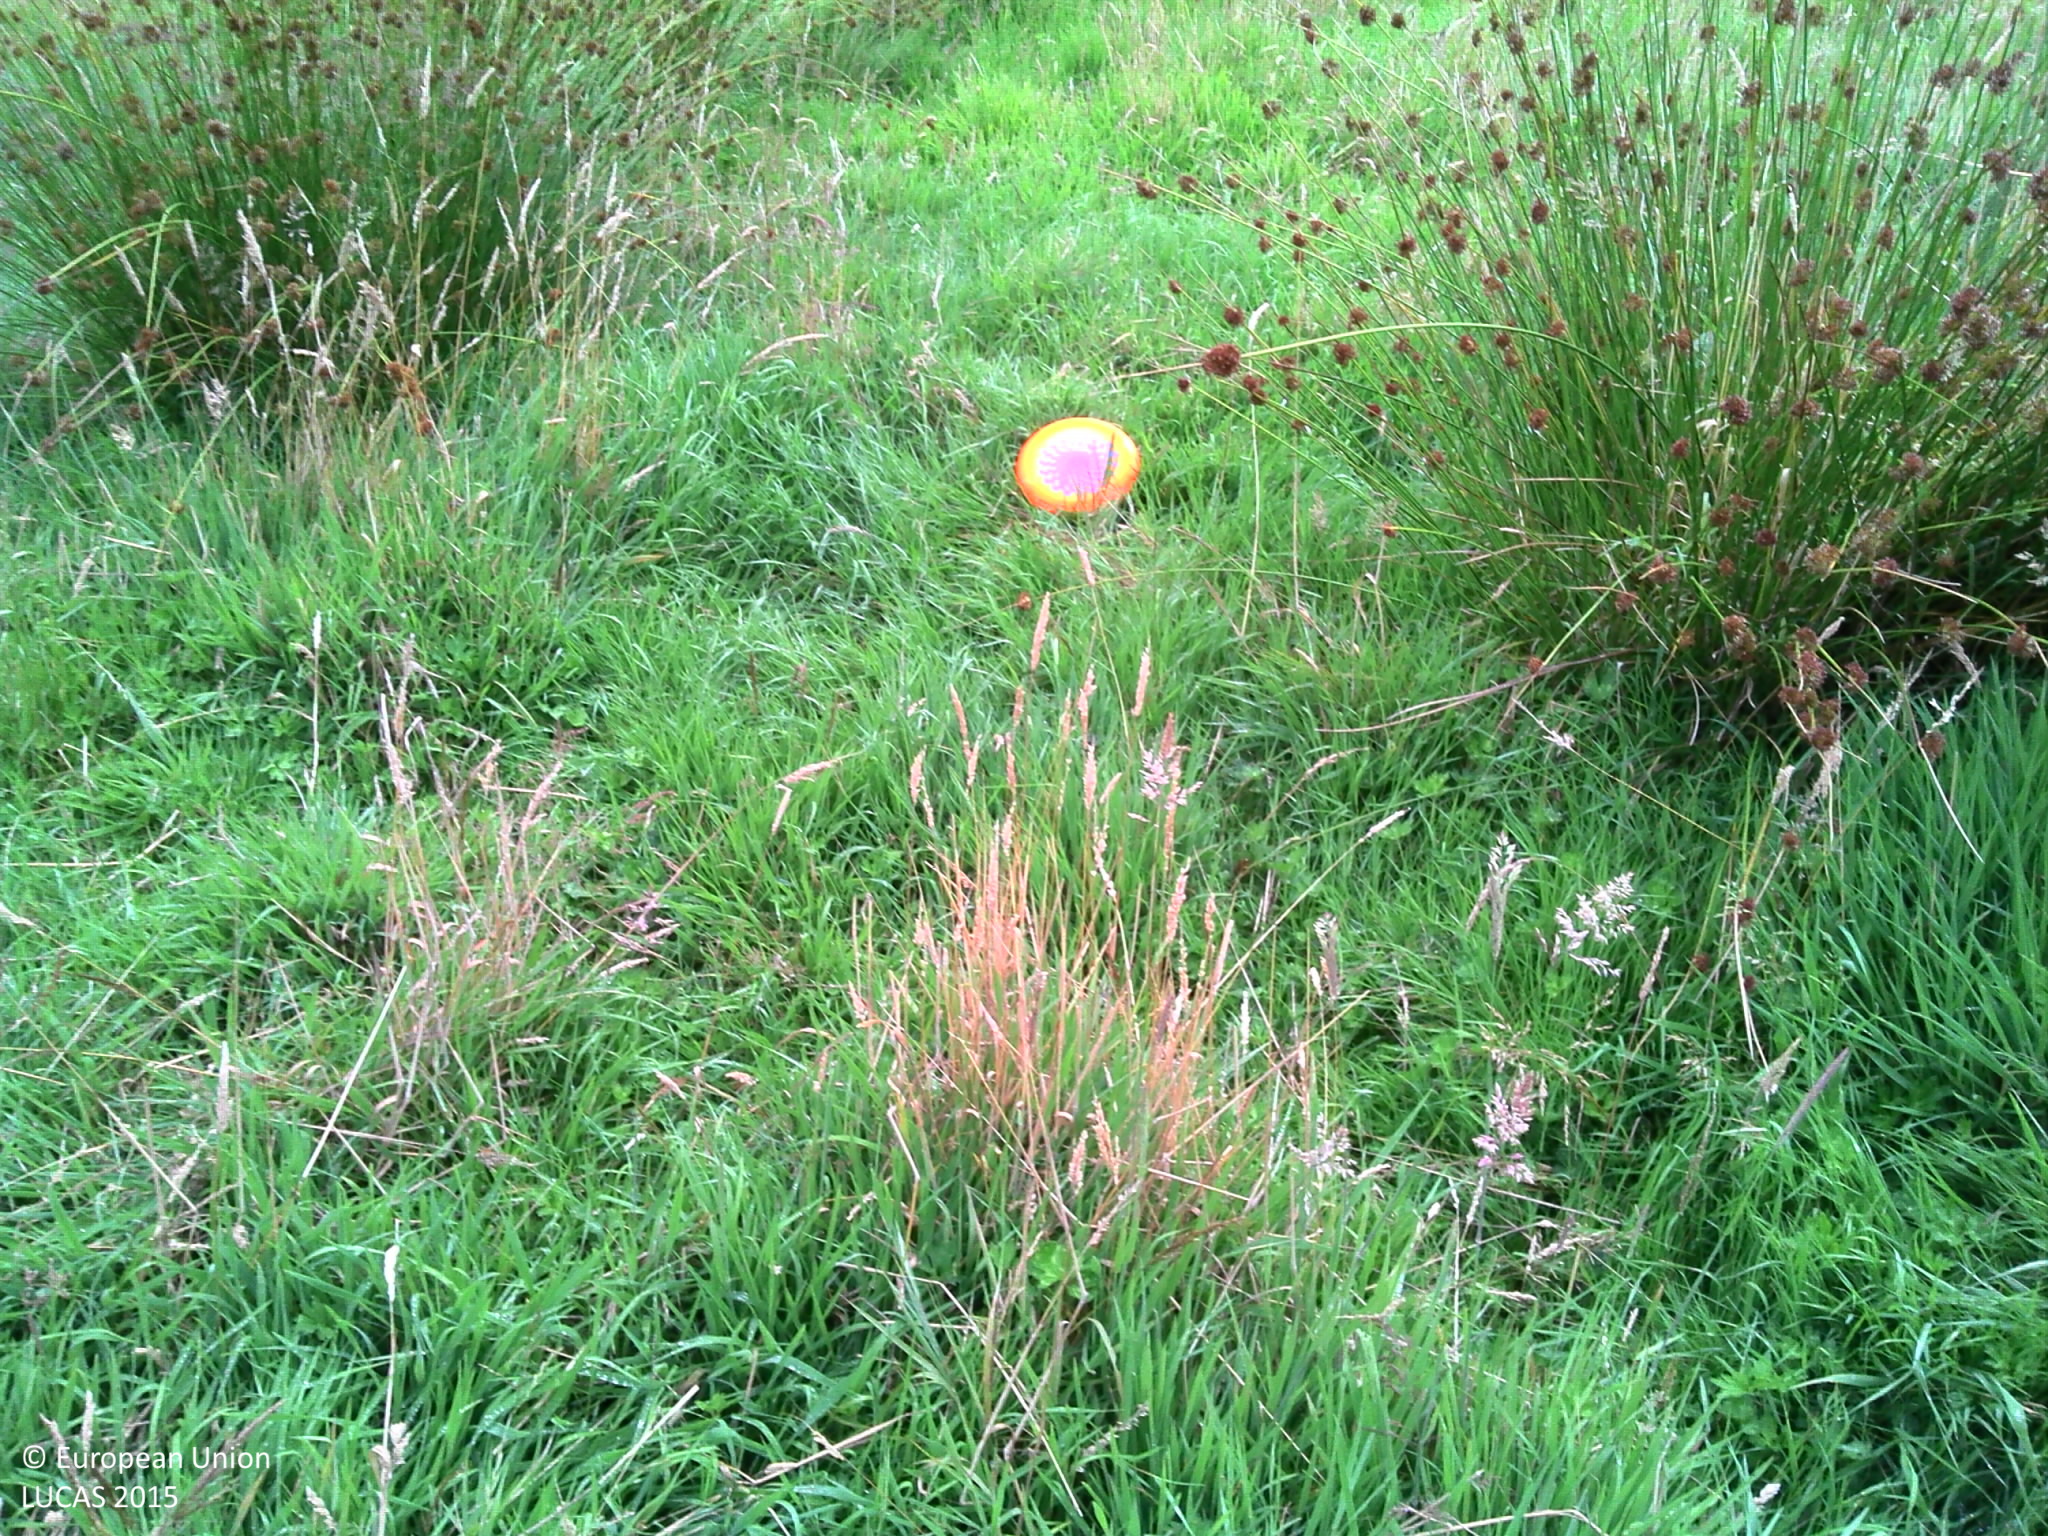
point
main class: Grassland
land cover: Grassland without tree/shrub cover
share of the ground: > 75 %
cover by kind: herbaceous plants 100 %
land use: Agriculture (excluding fallow land and kitchen gardens)
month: July
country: FR
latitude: 48.1340
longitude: -3.6656
